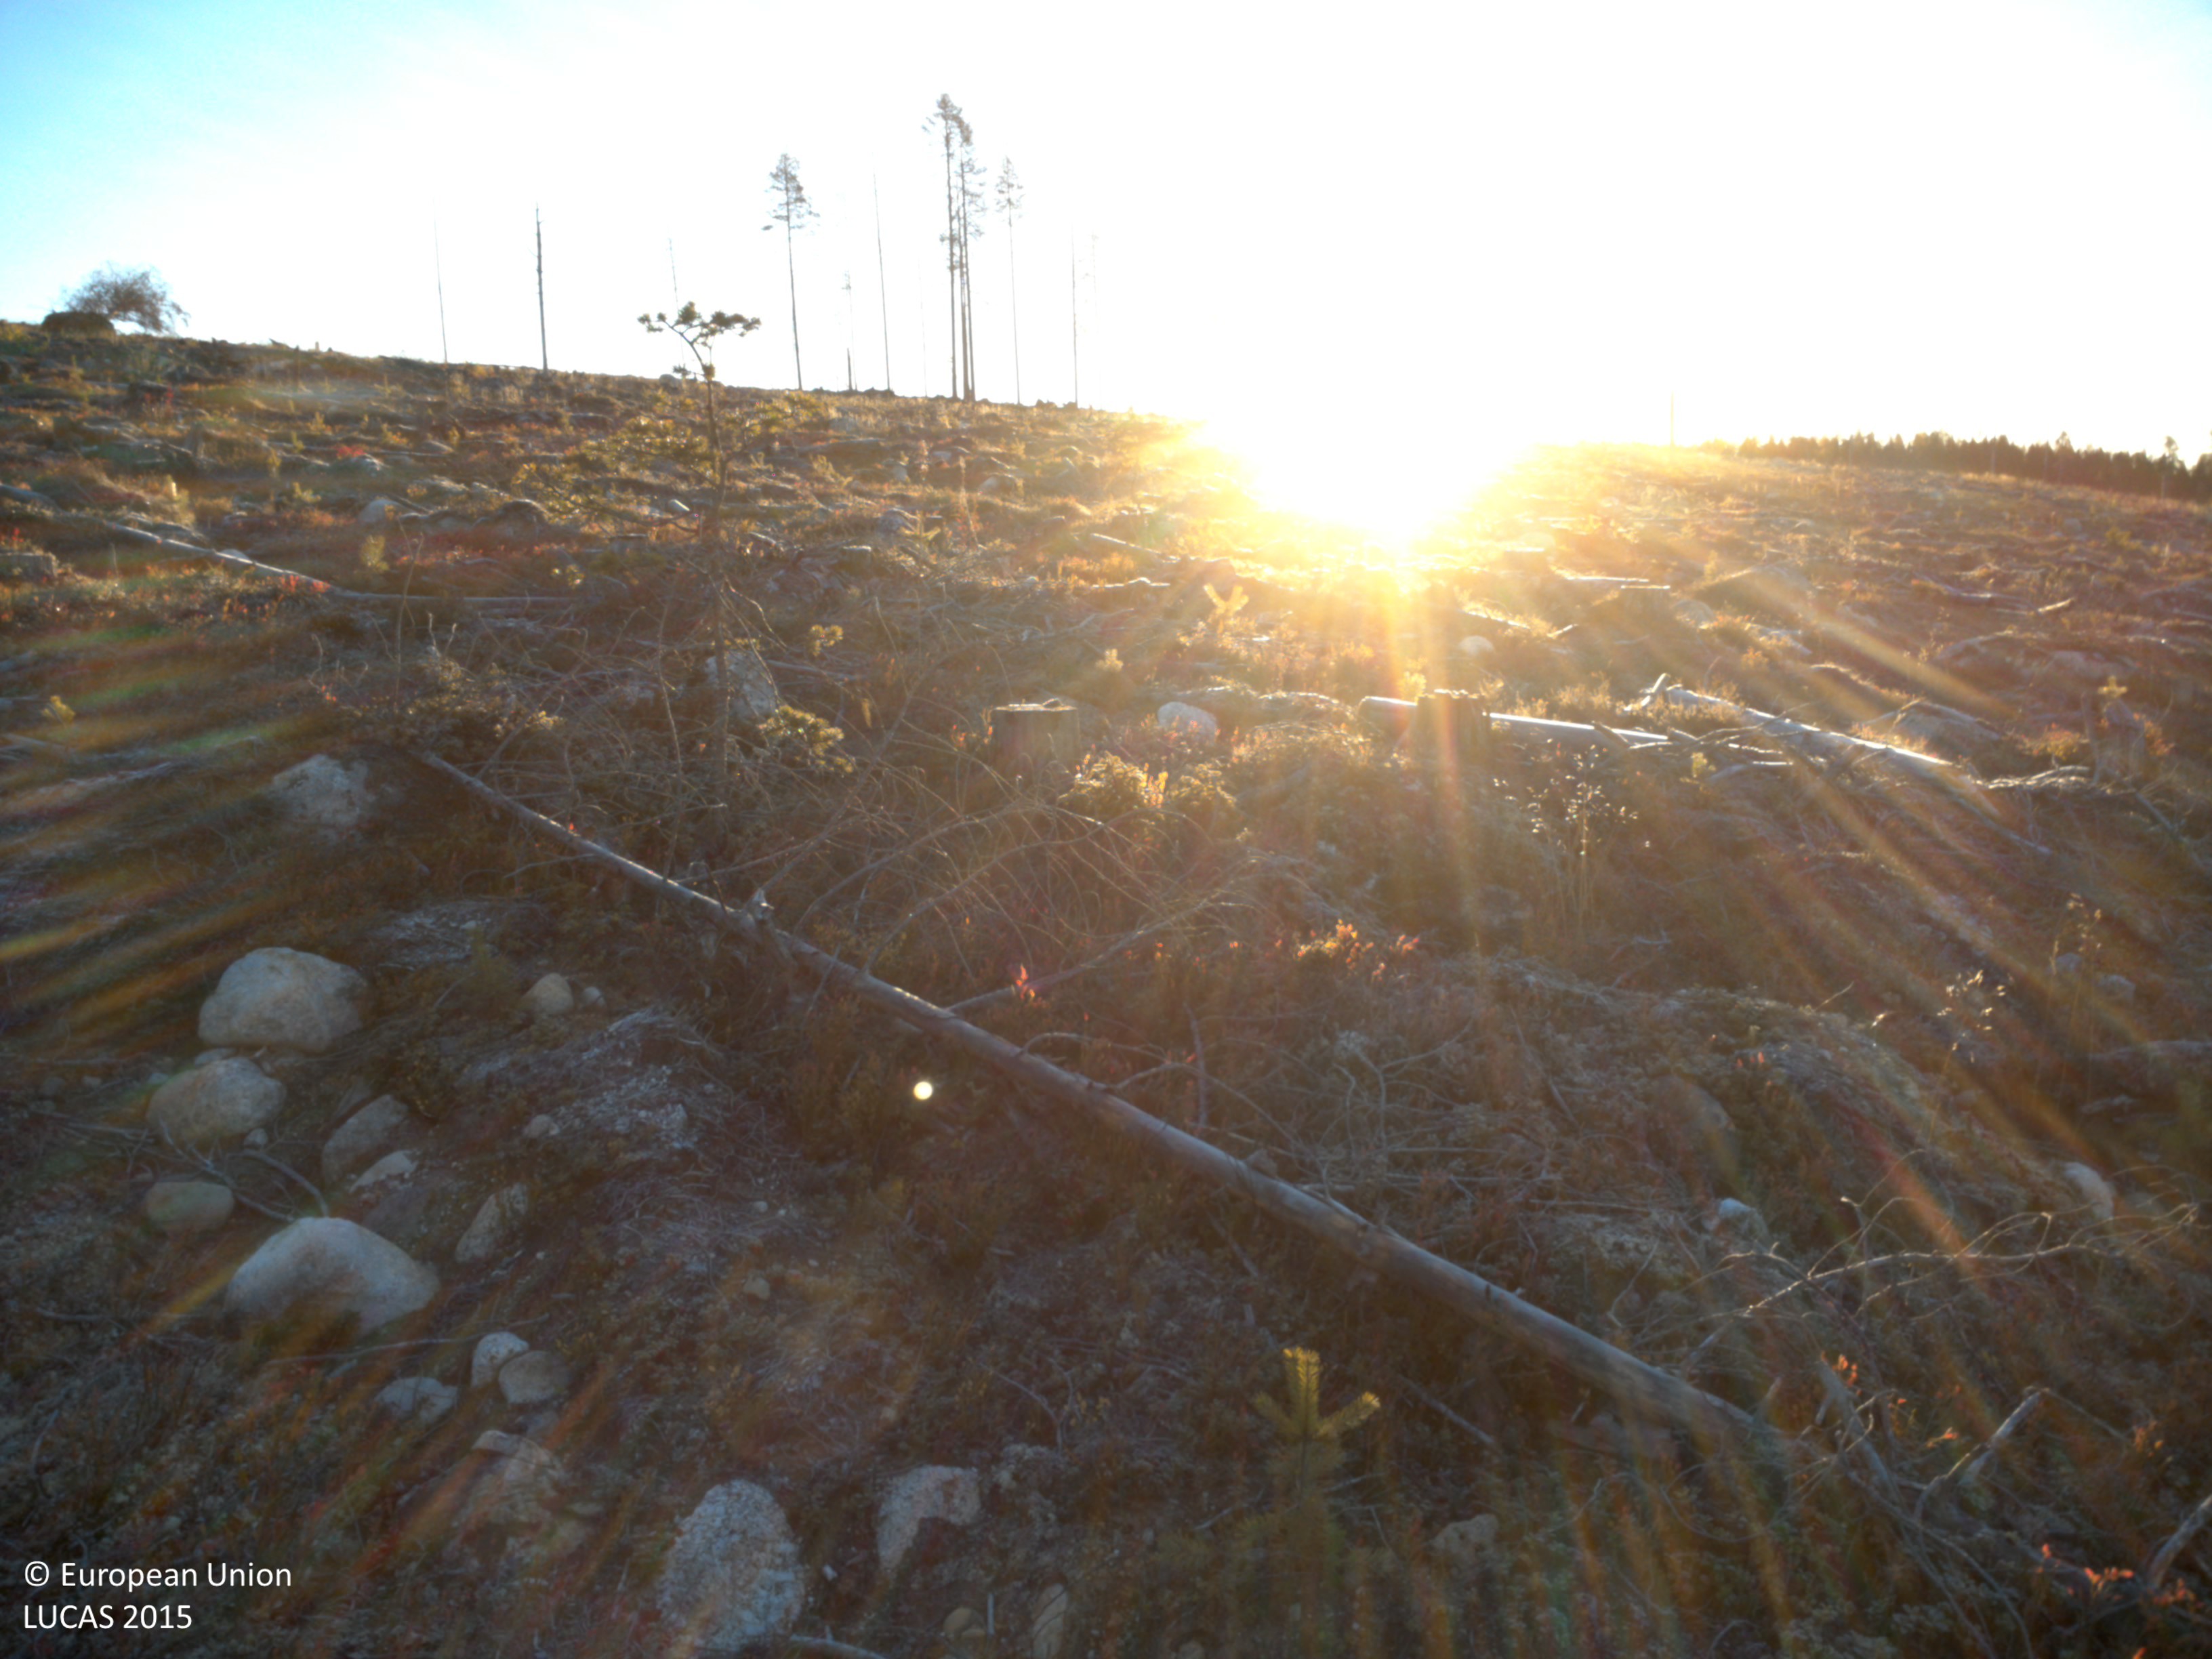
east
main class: Shrubland
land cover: Shrubland with sparse tree cover
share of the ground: 25 - 50 %
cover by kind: shrubs 50 %, consolidated bare surface 20 %, herbaceous plants 15 %, unconsolidated bare surface 10 %, coniferous forest trees 5 %
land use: Forestry
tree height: < 5 m
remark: Clear cut
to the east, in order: Shrubland with sparse tree cover; Ditches and canals; Paved roads, cycling and walking lanes; Ditches and canals
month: October
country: SE
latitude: 64.7090
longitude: 17.9169
